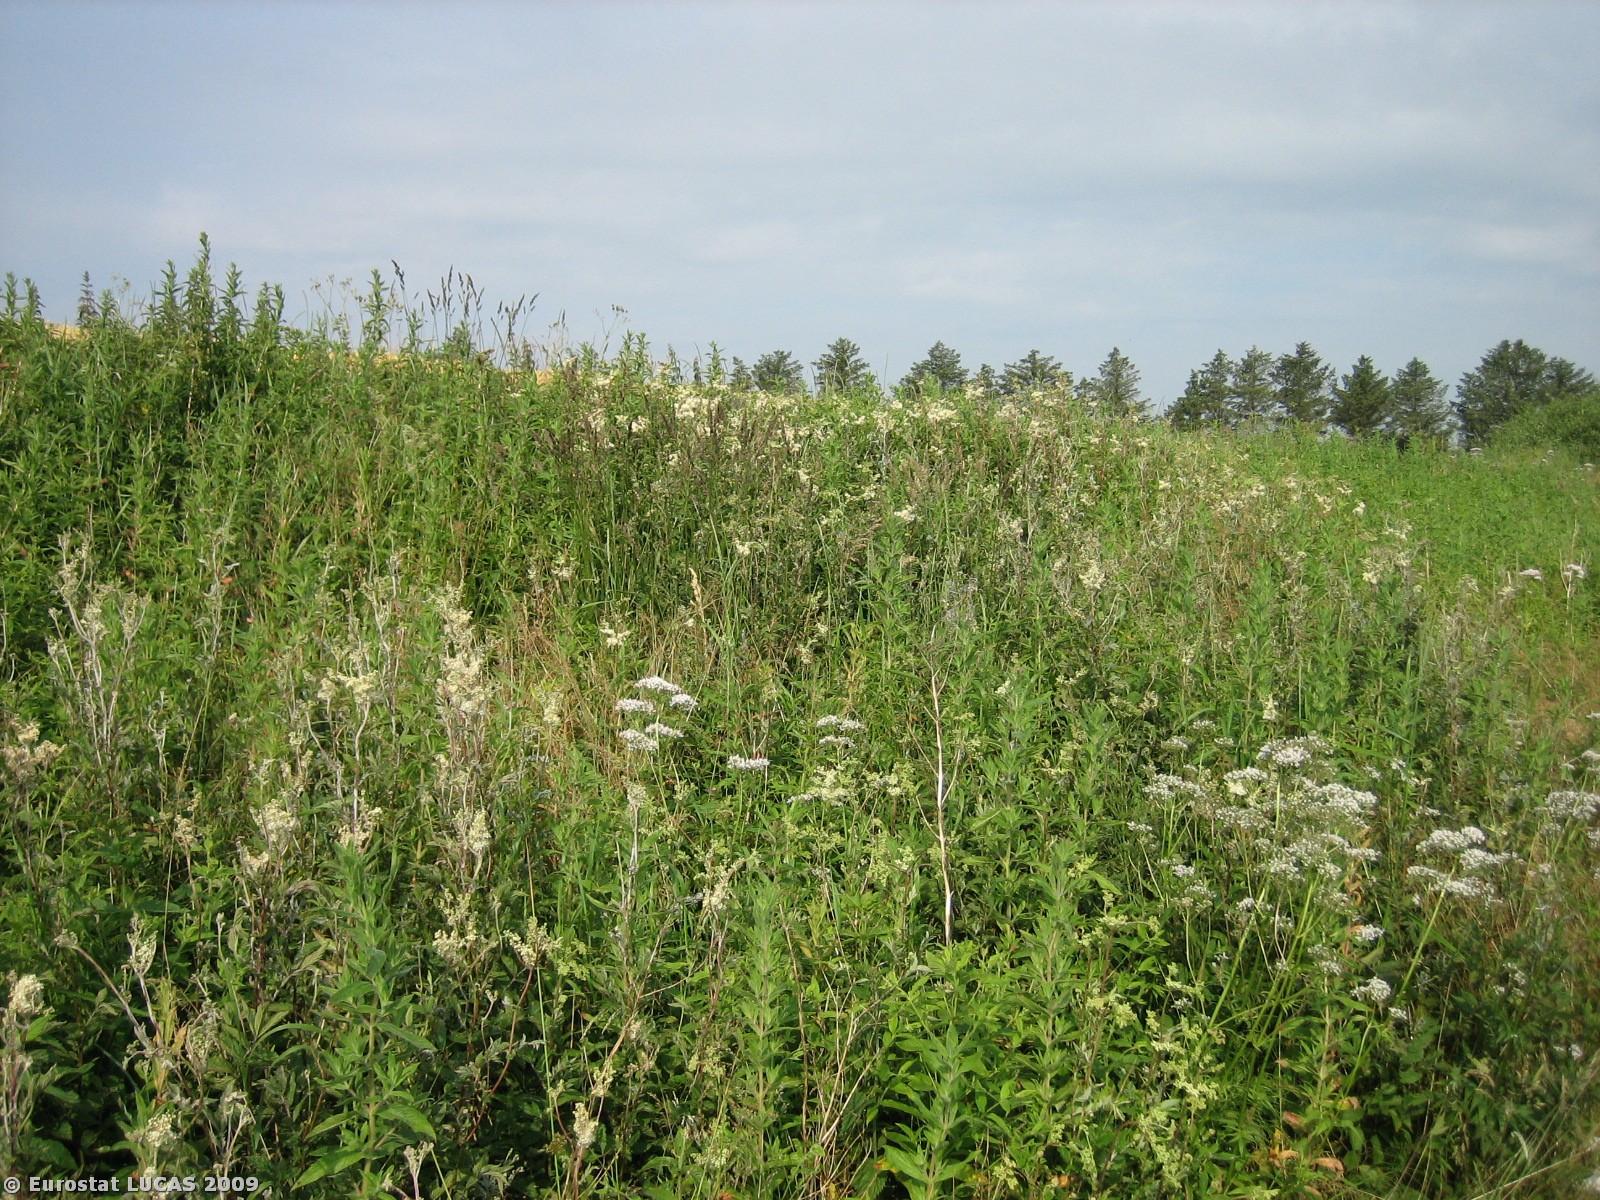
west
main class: Grassland
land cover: Grassland without tree/shrub cover
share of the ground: > 75 %
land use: Unused
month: July
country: DK
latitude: 55.3018
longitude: 8.8511
